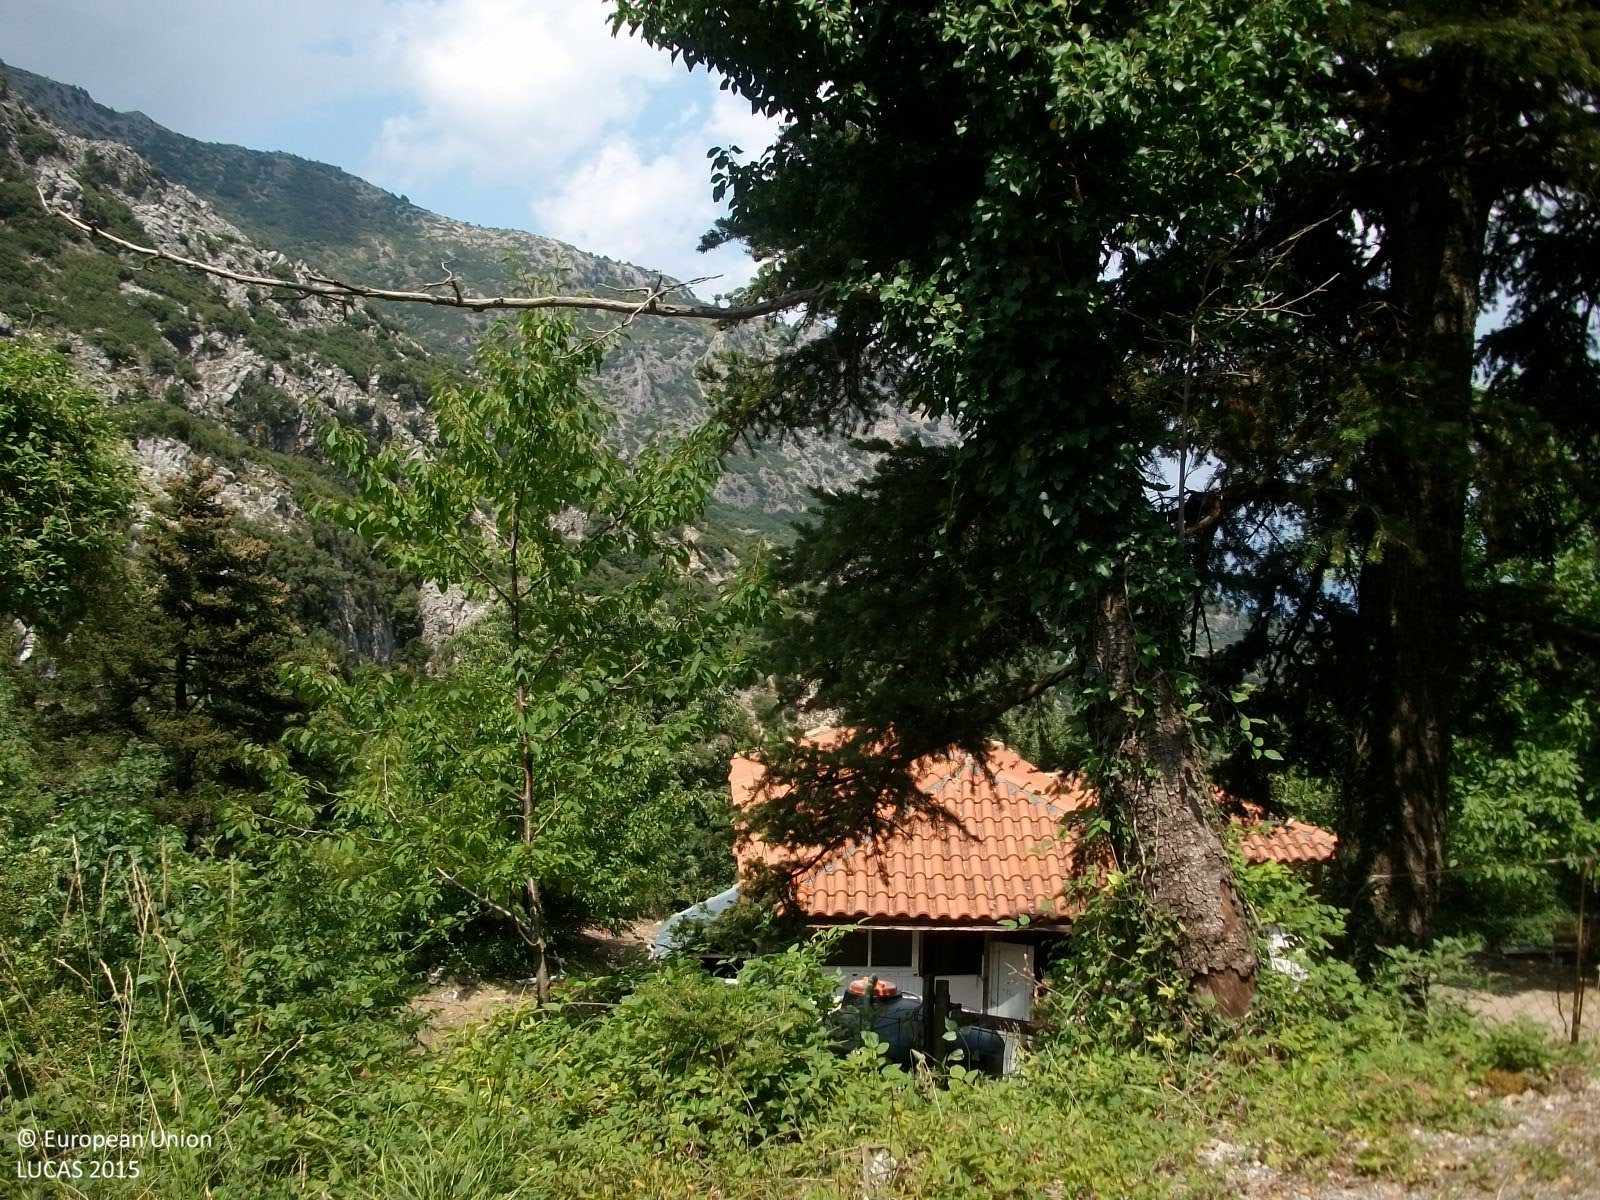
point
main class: Shrubland
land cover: Shrubland with sparse tree cover
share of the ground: 50 - 75 %
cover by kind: herbaceous plants 45 %, shrubs 30 %, unconsolidated bare surface 15 %, broadleaved forest trees 5 %, consolidated bare surface 5 %
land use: Semi-natural and natural areas not in use
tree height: > 5 m
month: July
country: GR
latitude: 36.9707
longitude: 22.3888
